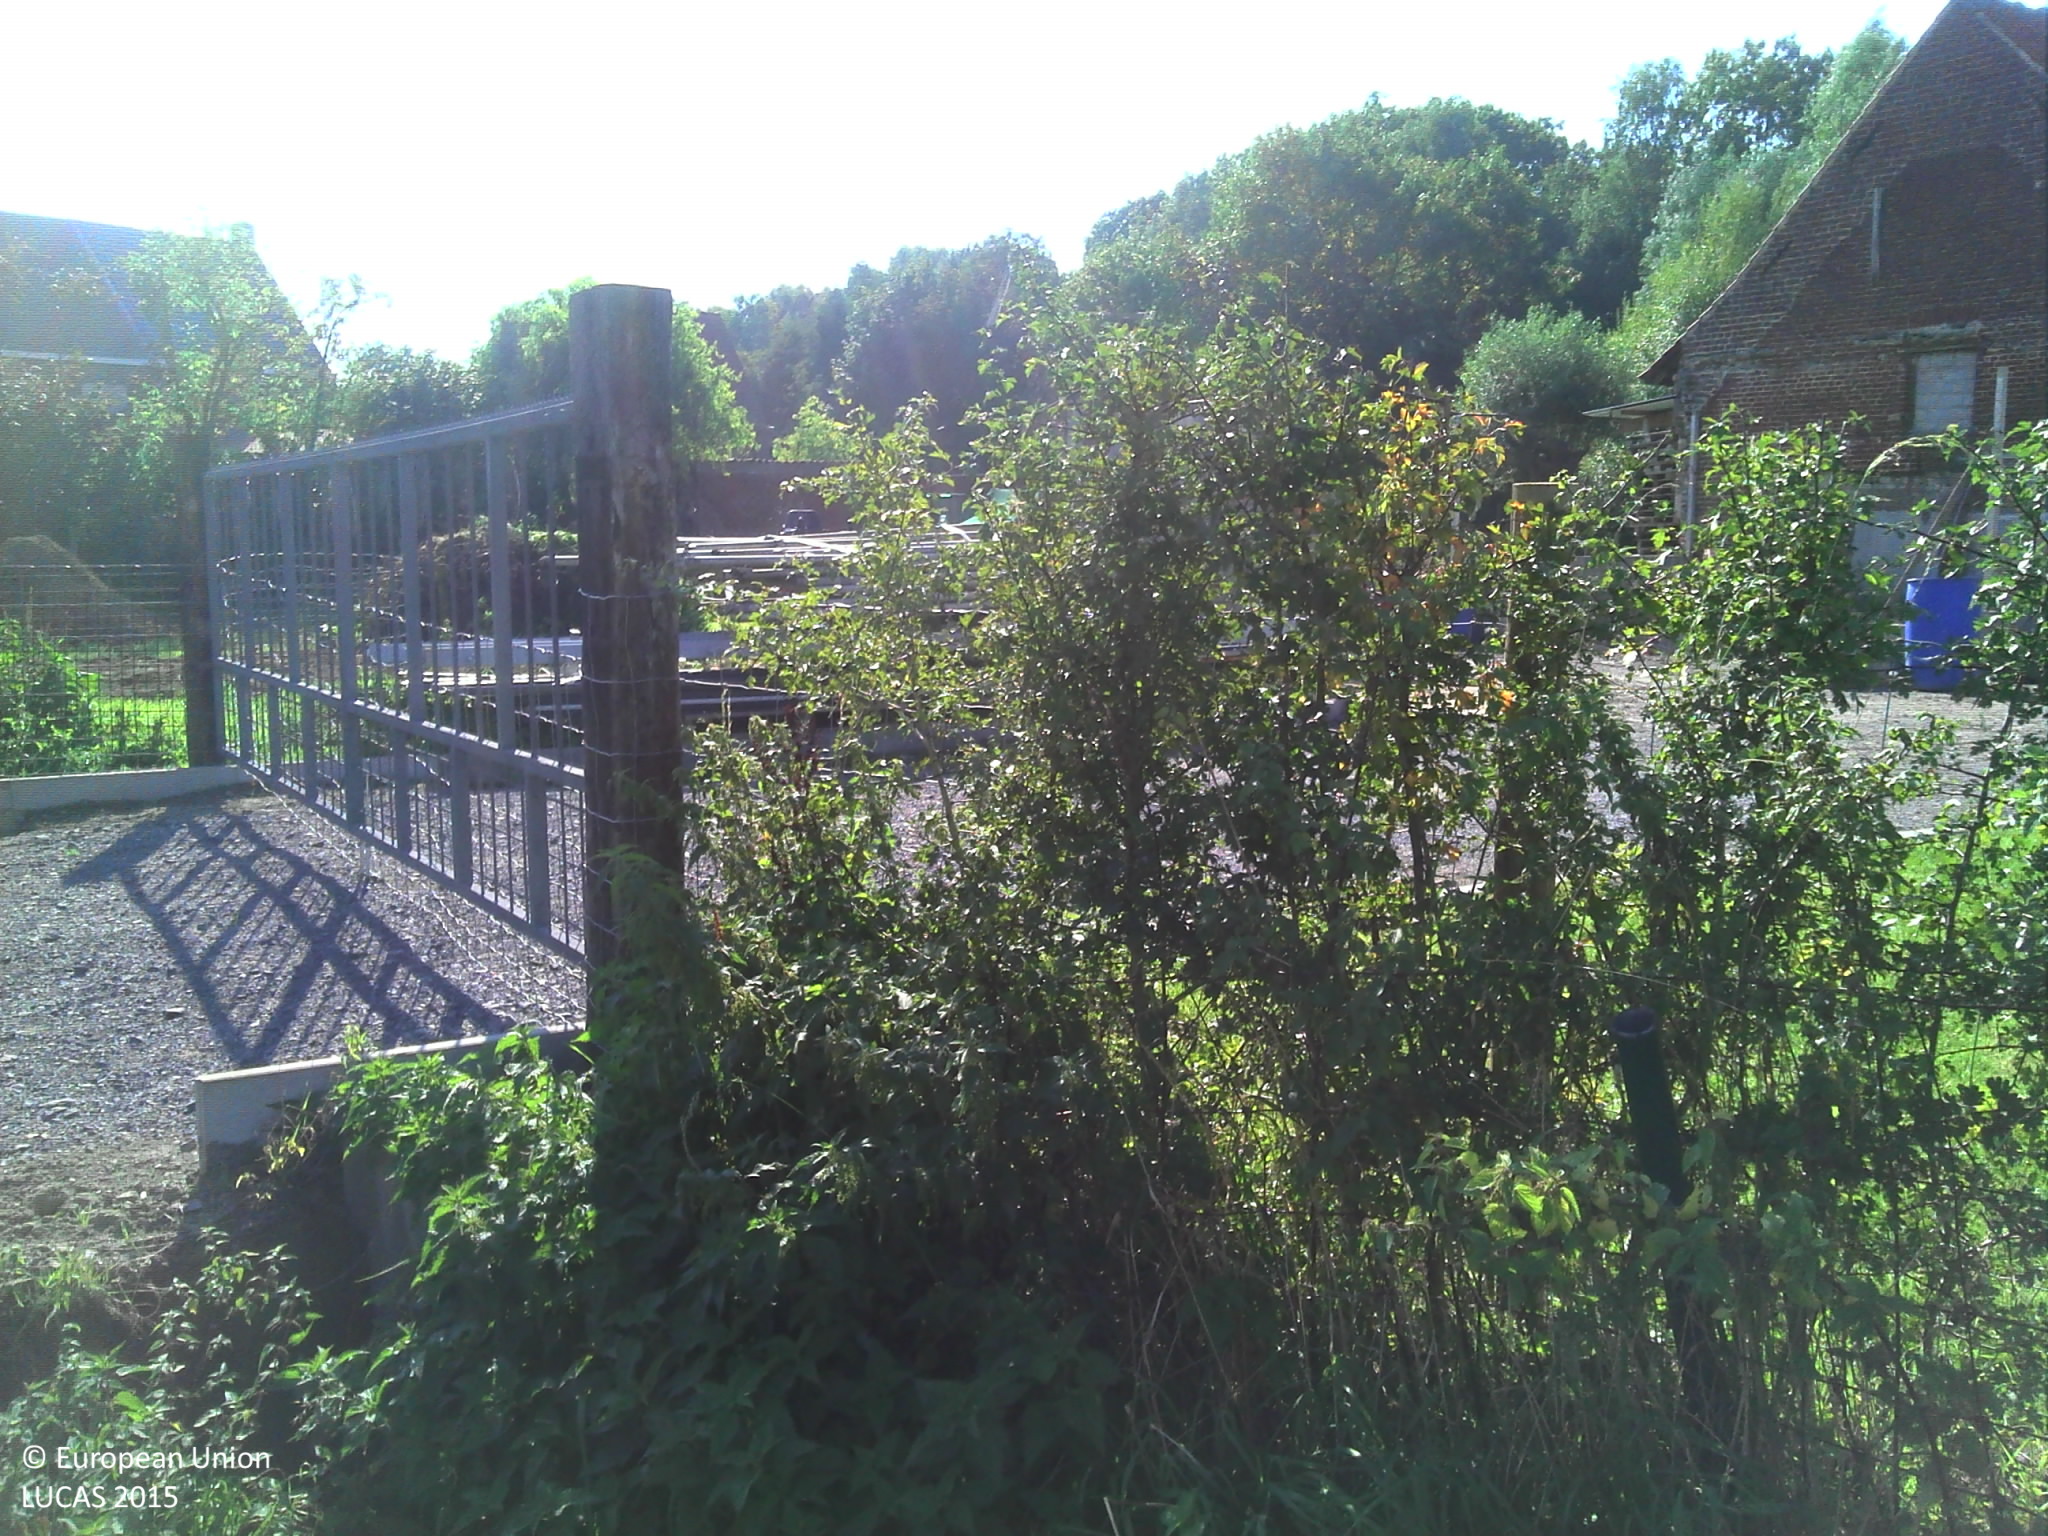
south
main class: Grassland
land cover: Grassland without tree/shrub cover
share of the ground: > 75 %
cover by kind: herbaceous plants 80 %, unconsolidated bare surface 20 %
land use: Residential
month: October
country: BE
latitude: 51.0187
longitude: 3.0477
